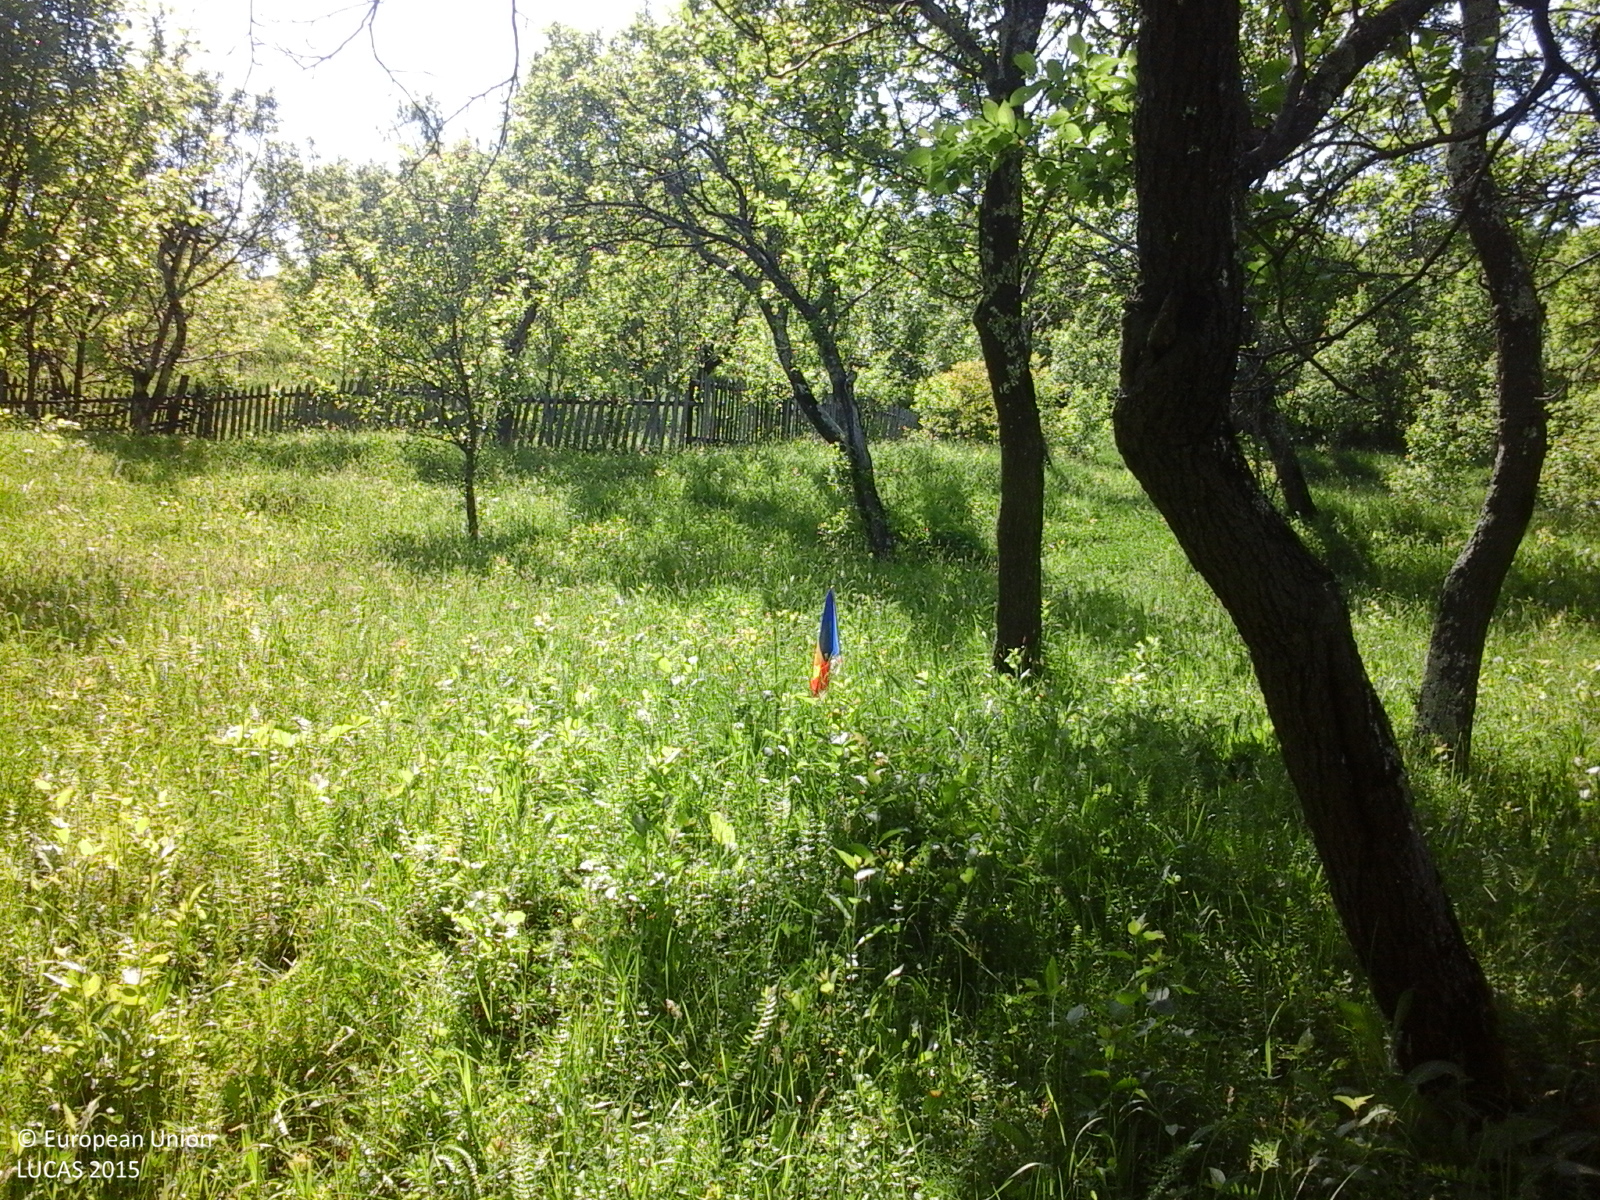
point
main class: Cropland
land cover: Other fruit trees and berries
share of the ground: 50 - 75 %
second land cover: Grassland without tree/shrub cover
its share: > 75 %
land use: Agriculture (excluding fallow land and kitchen gardens)
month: May
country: RO
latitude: 45.4772
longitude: 26.4077
